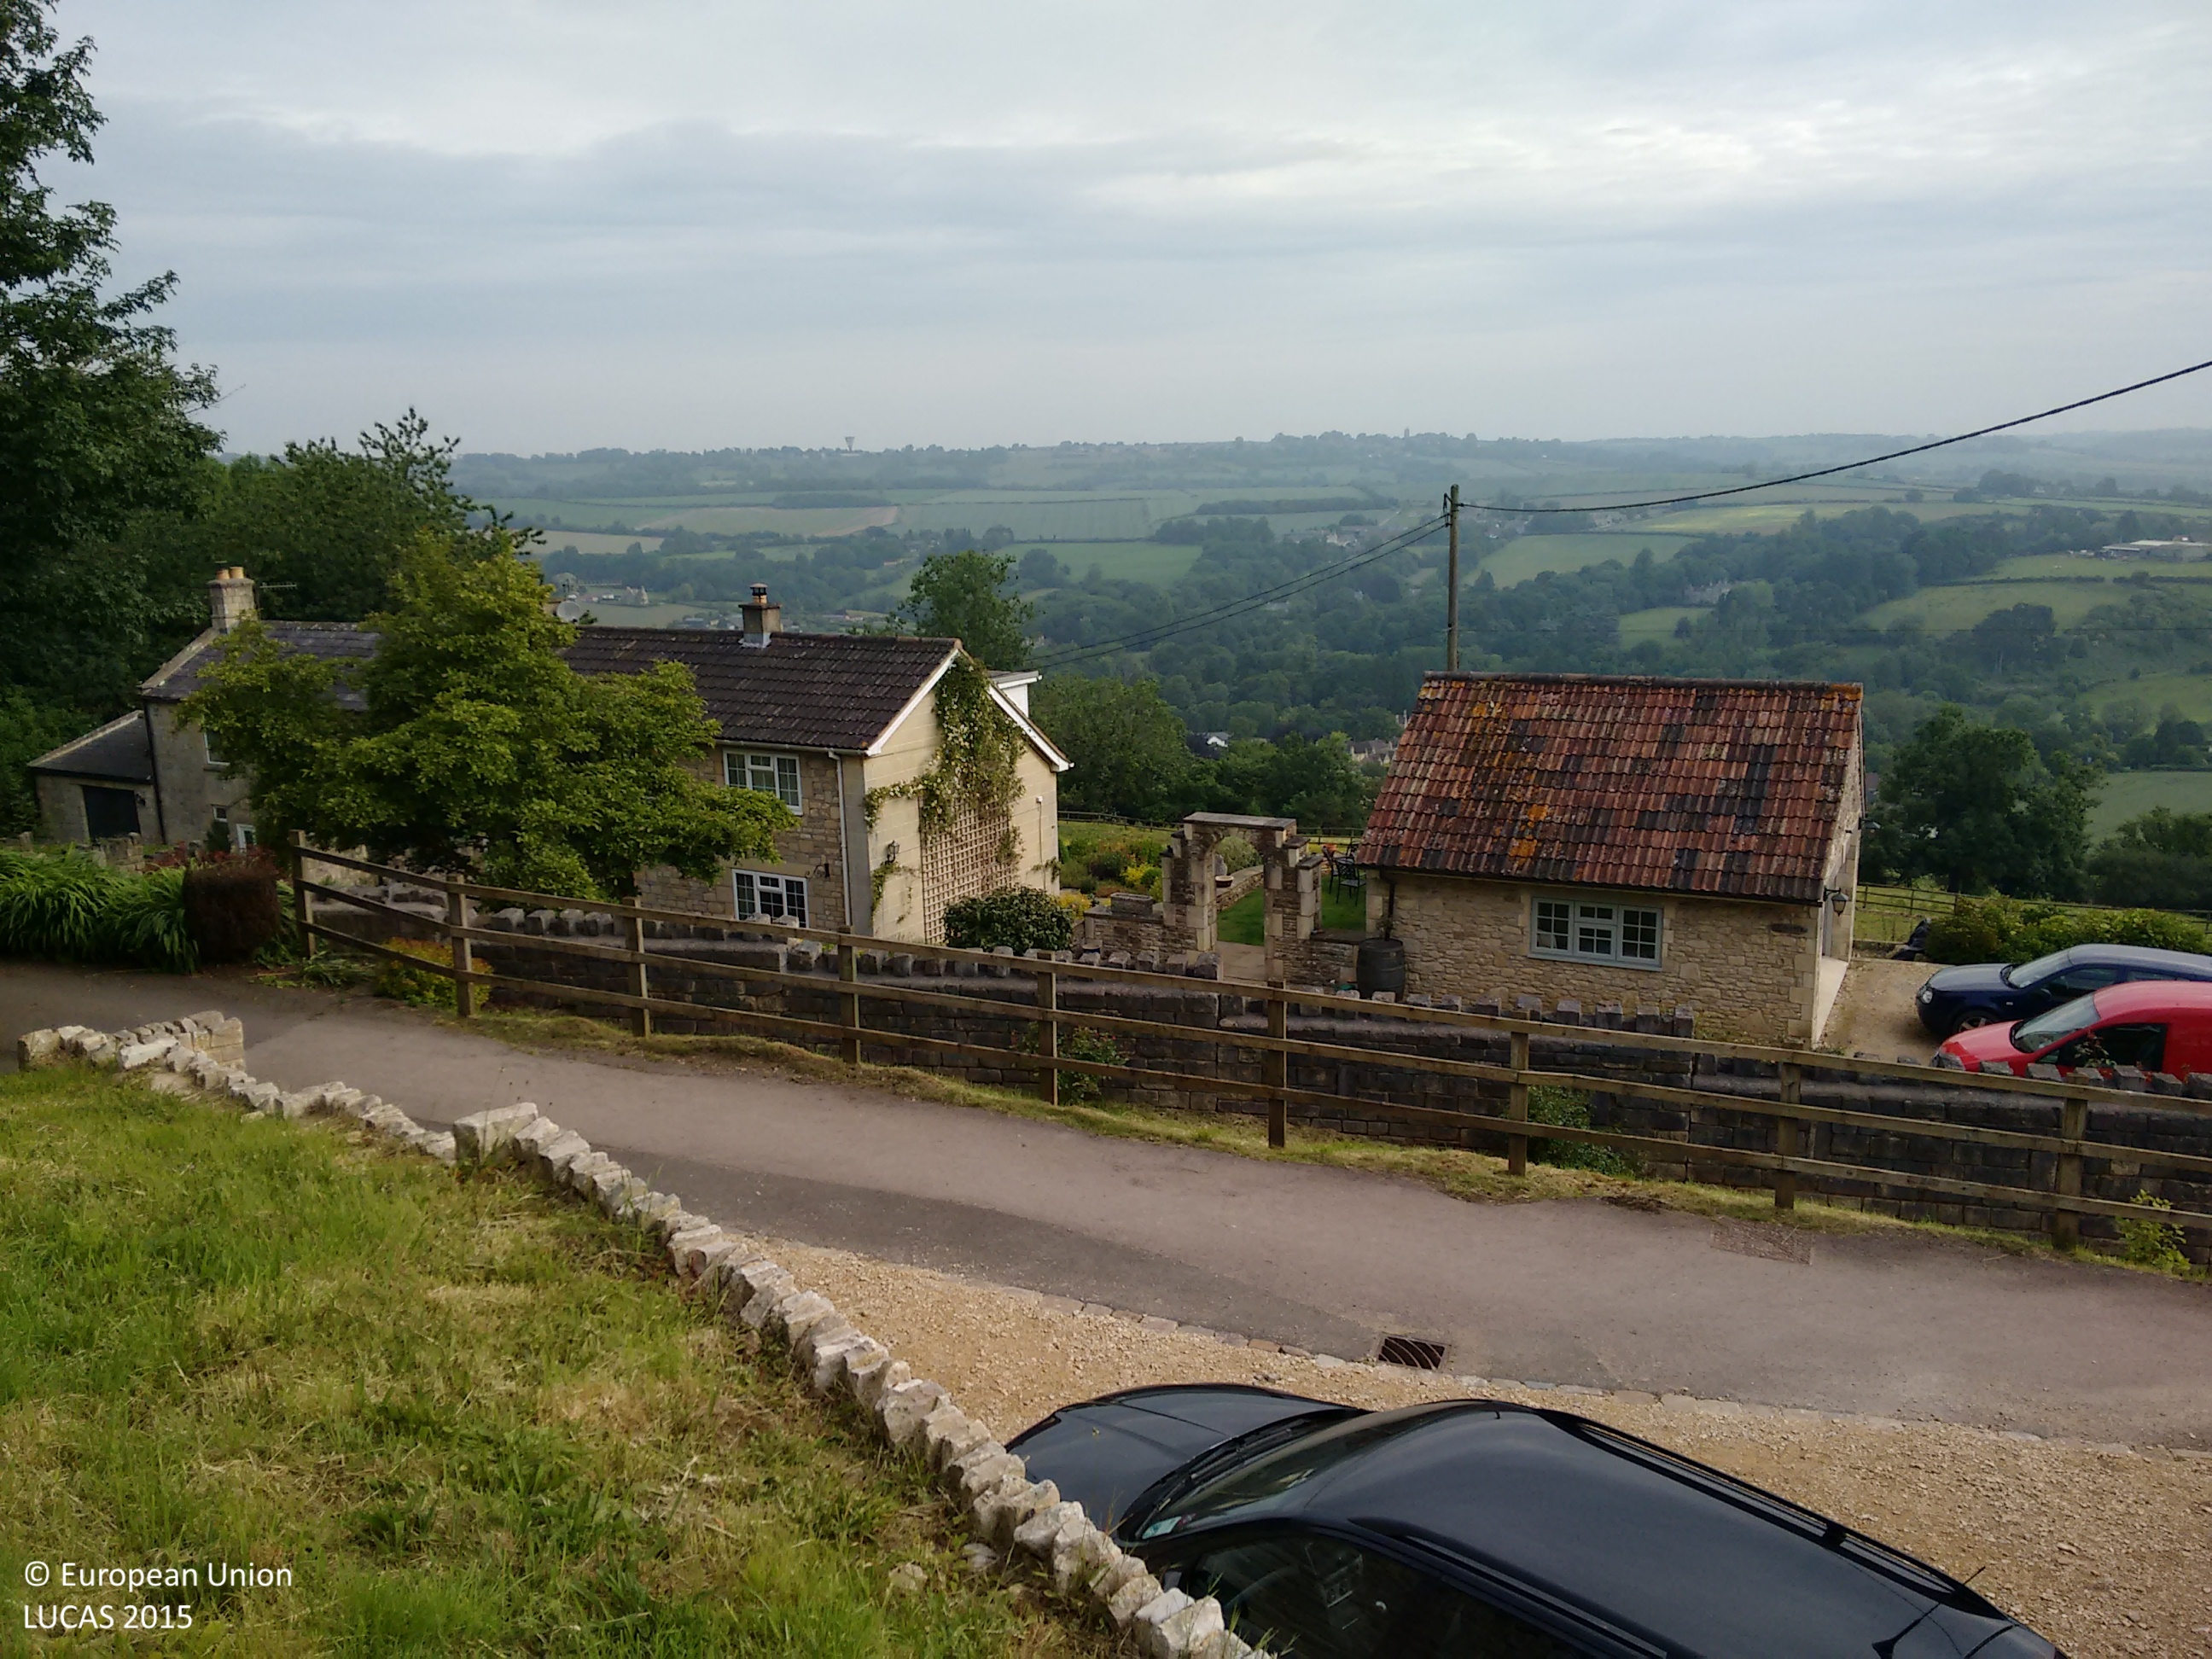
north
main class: Grassland
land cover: Grassland with sparse tree/shrub cover
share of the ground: > 75 %
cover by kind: herbaceous plants 95 %, broadleaved forest trees 5 %
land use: Residential
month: June
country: GB
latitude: 51.4106
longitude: -2.2690
